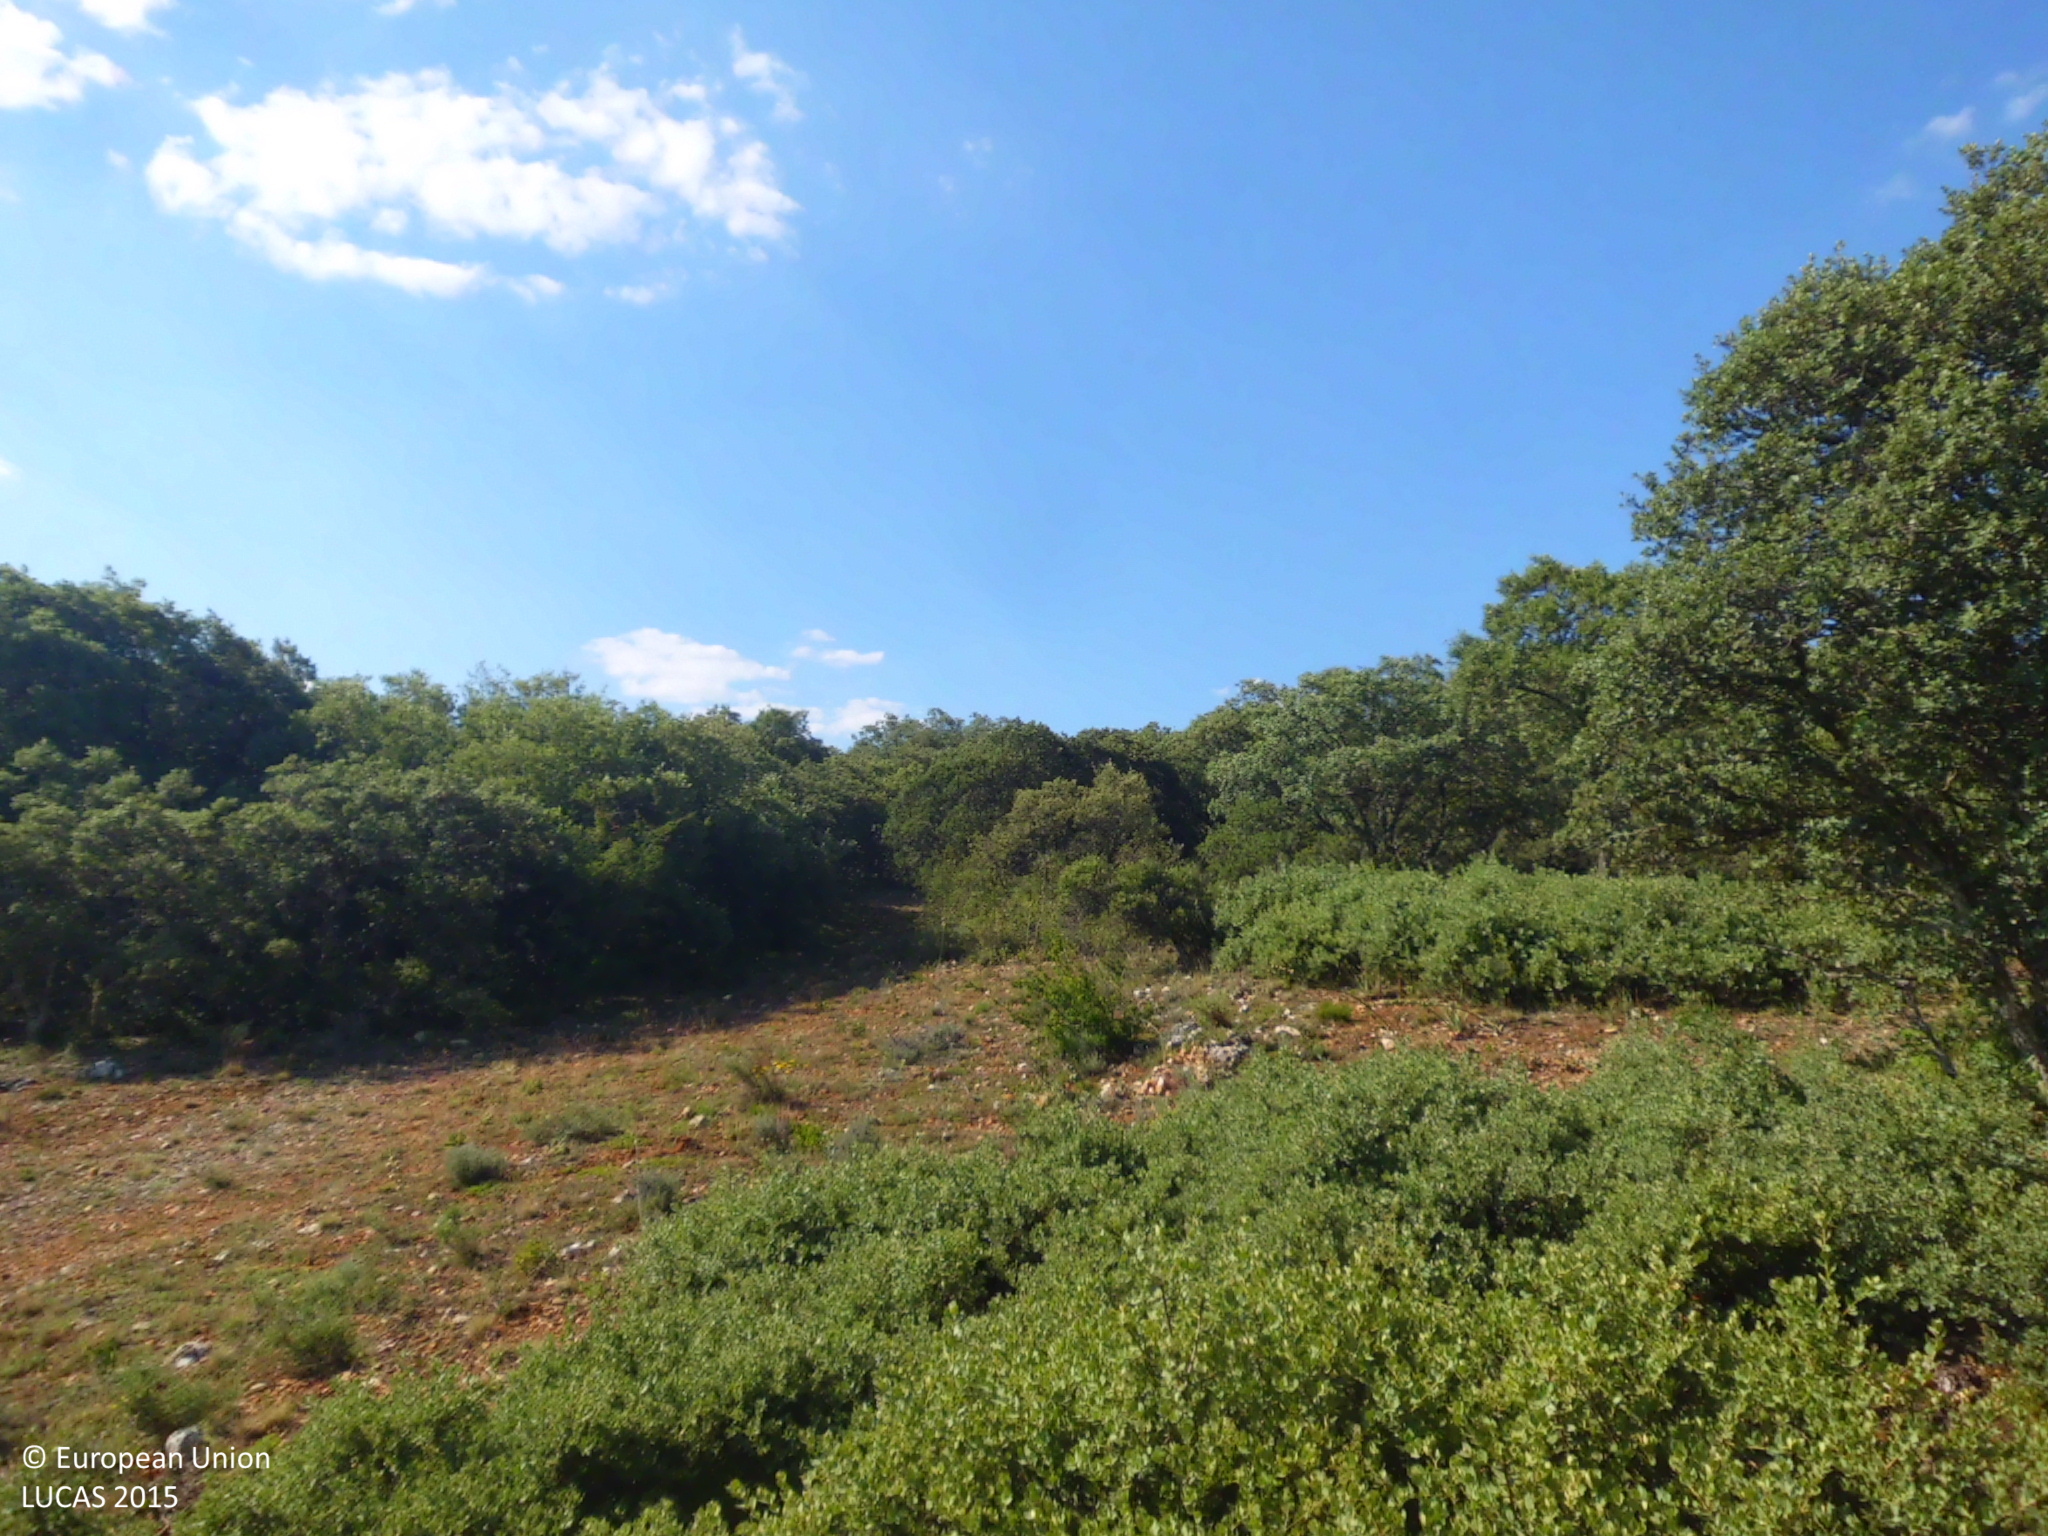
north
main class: Woodland
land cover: Broadleaved woodland
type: broadleaved evergreen forest
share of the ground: 50 - 75 %
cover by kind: broadleaved forest trees 60 %, shrubs 15 %, consolidated bare surface 15 %, herbaceous plants 10 %
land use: Semi-natural and natural areas not in use
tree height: > 5 m
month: June
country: ES
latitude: 42.6170
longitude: -4.0773
